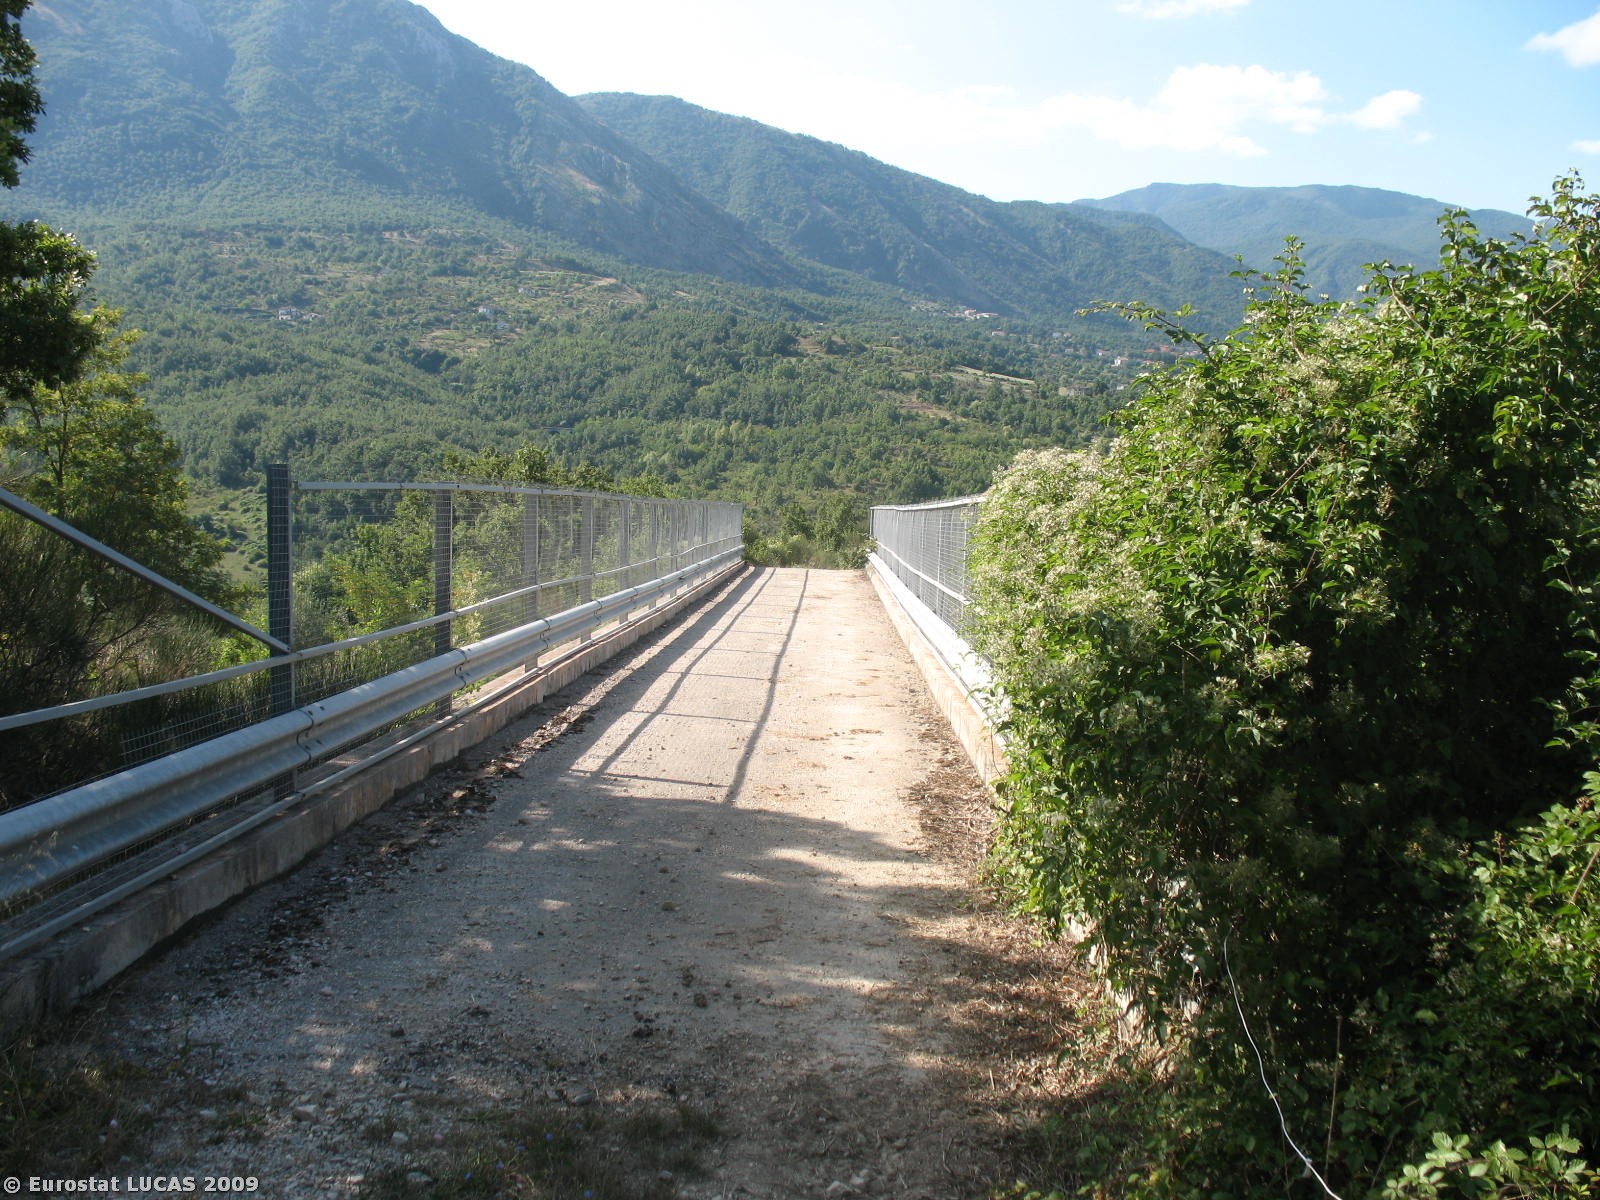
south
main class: Woodland
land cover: Broadleaved woodland
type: mesophytic deciduous forest
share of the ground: > 75 %
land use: Agriculture (excluding fallow land and kitchen gardens)
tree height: > 5 m
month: July
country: IT
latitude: 40.8613
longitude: 15.0696
